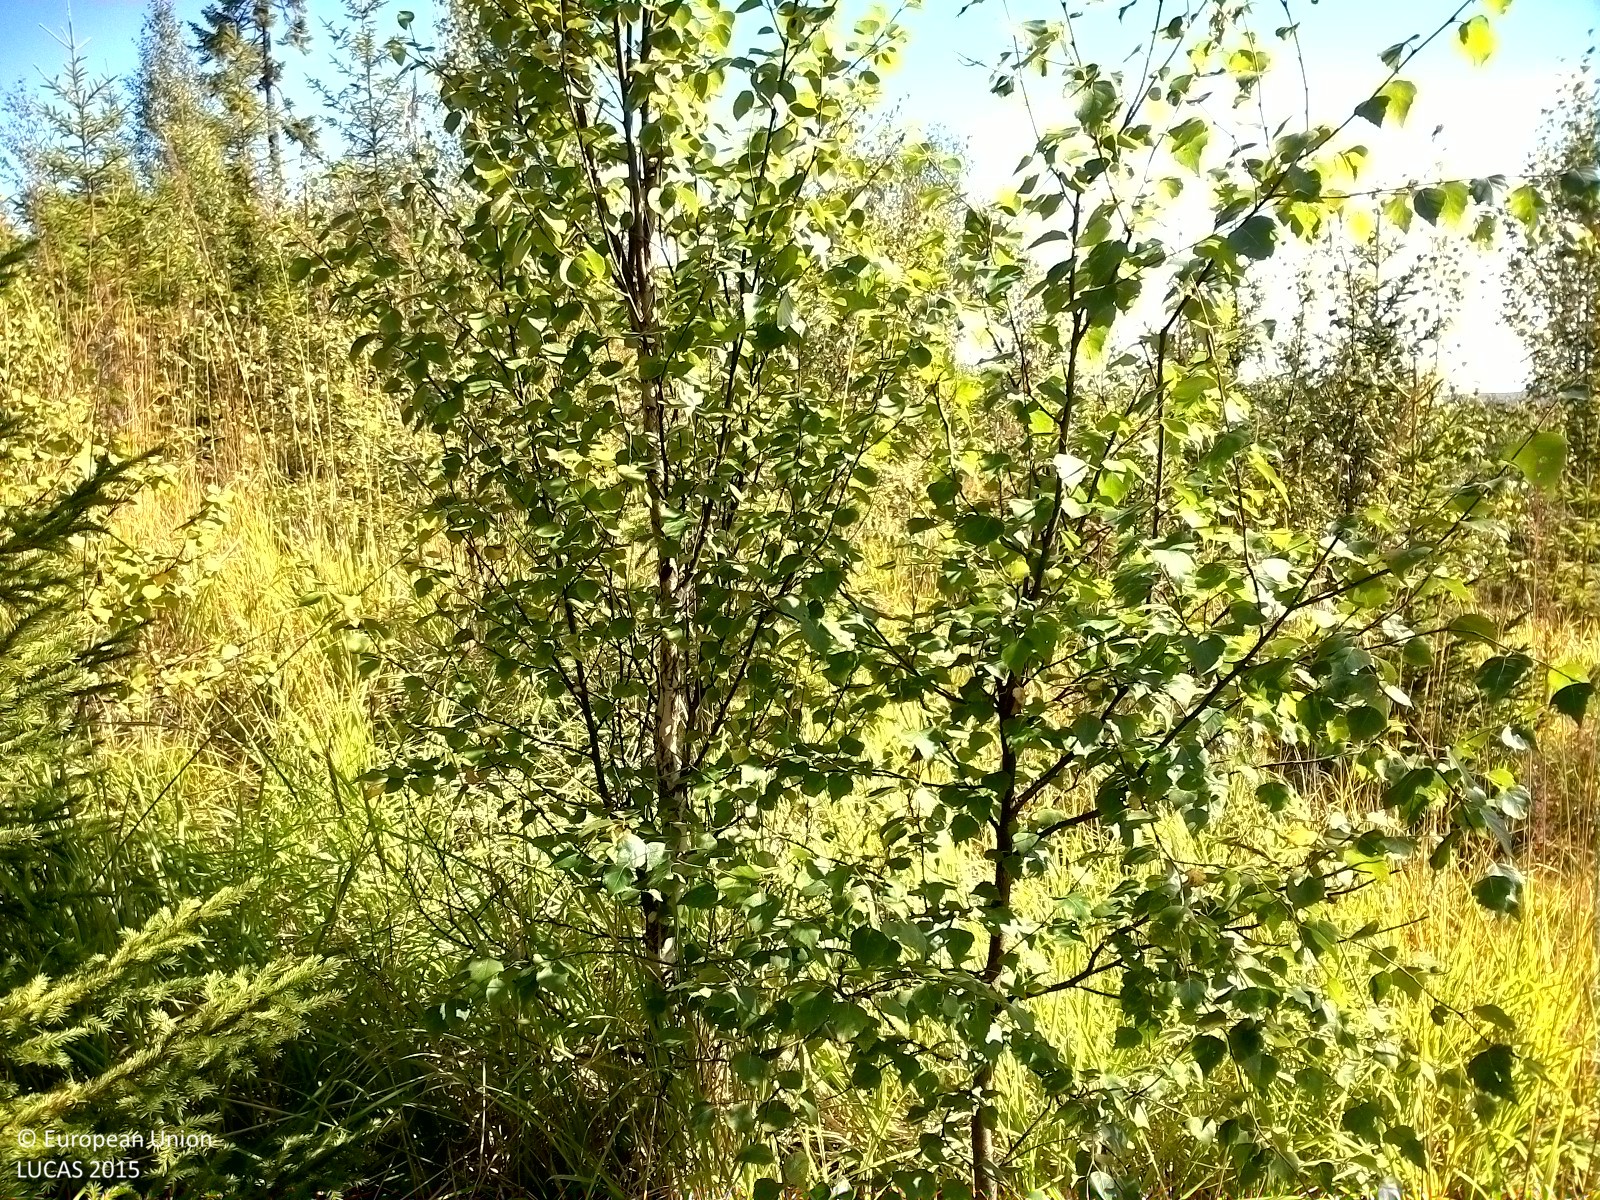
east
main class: Woodland
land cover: Spruce dominated mixed woodland
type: boreal forest
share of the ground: 25 - 50 %
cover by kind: herbaceous plants 60 %, coniferous forest trees 20 %, broadleaved forest trees 20 %
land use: Forestry
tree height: < 5 m
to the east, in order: Spruce dominated mixed woodland; Broadleaved woodland; Other mixed woodland
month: September
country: SE
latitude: 62.5872
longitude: 16.3452
